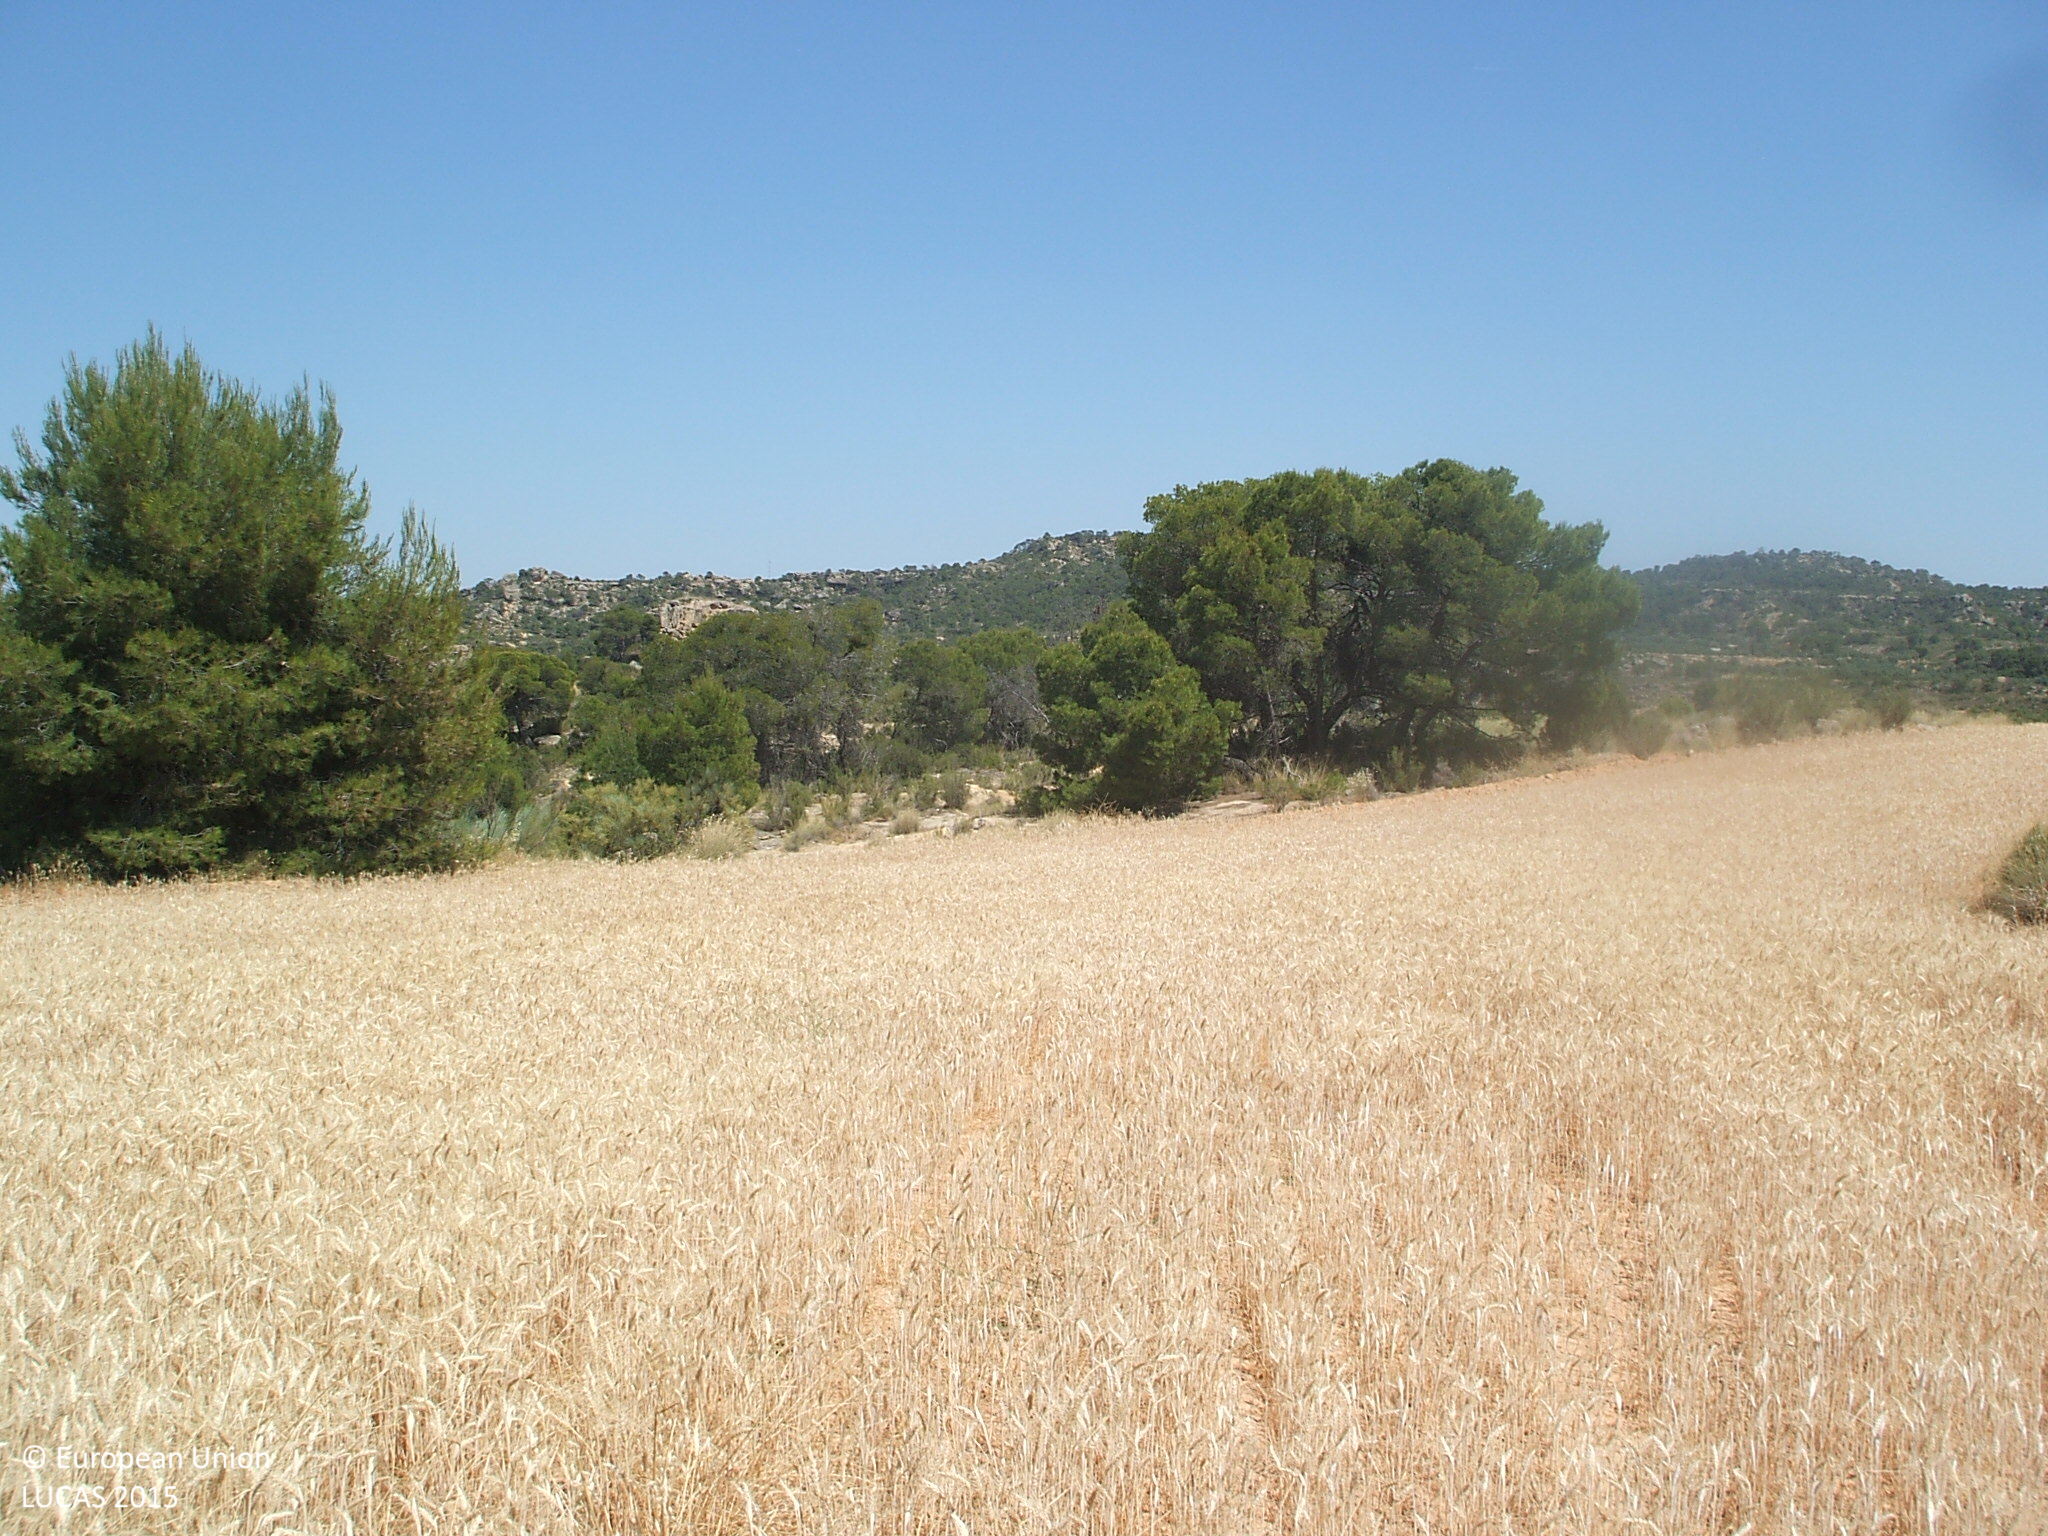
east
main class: Cropland
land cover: Common wheat
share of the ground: > 75 %
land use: Agriculture (excluding fallow land and kitchen gardens)
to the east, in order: Common wheat; Pine dominated coniferous woodland; Rocks and stones; Shruby margins; Tracks; Pine dominated coniferous woodland; Rocks and stones; Pine dominated coniferous woodland; Tracks; Grassland without tree/shrub cover
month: June
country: ES
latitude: 41.0955
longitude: -0.0718
